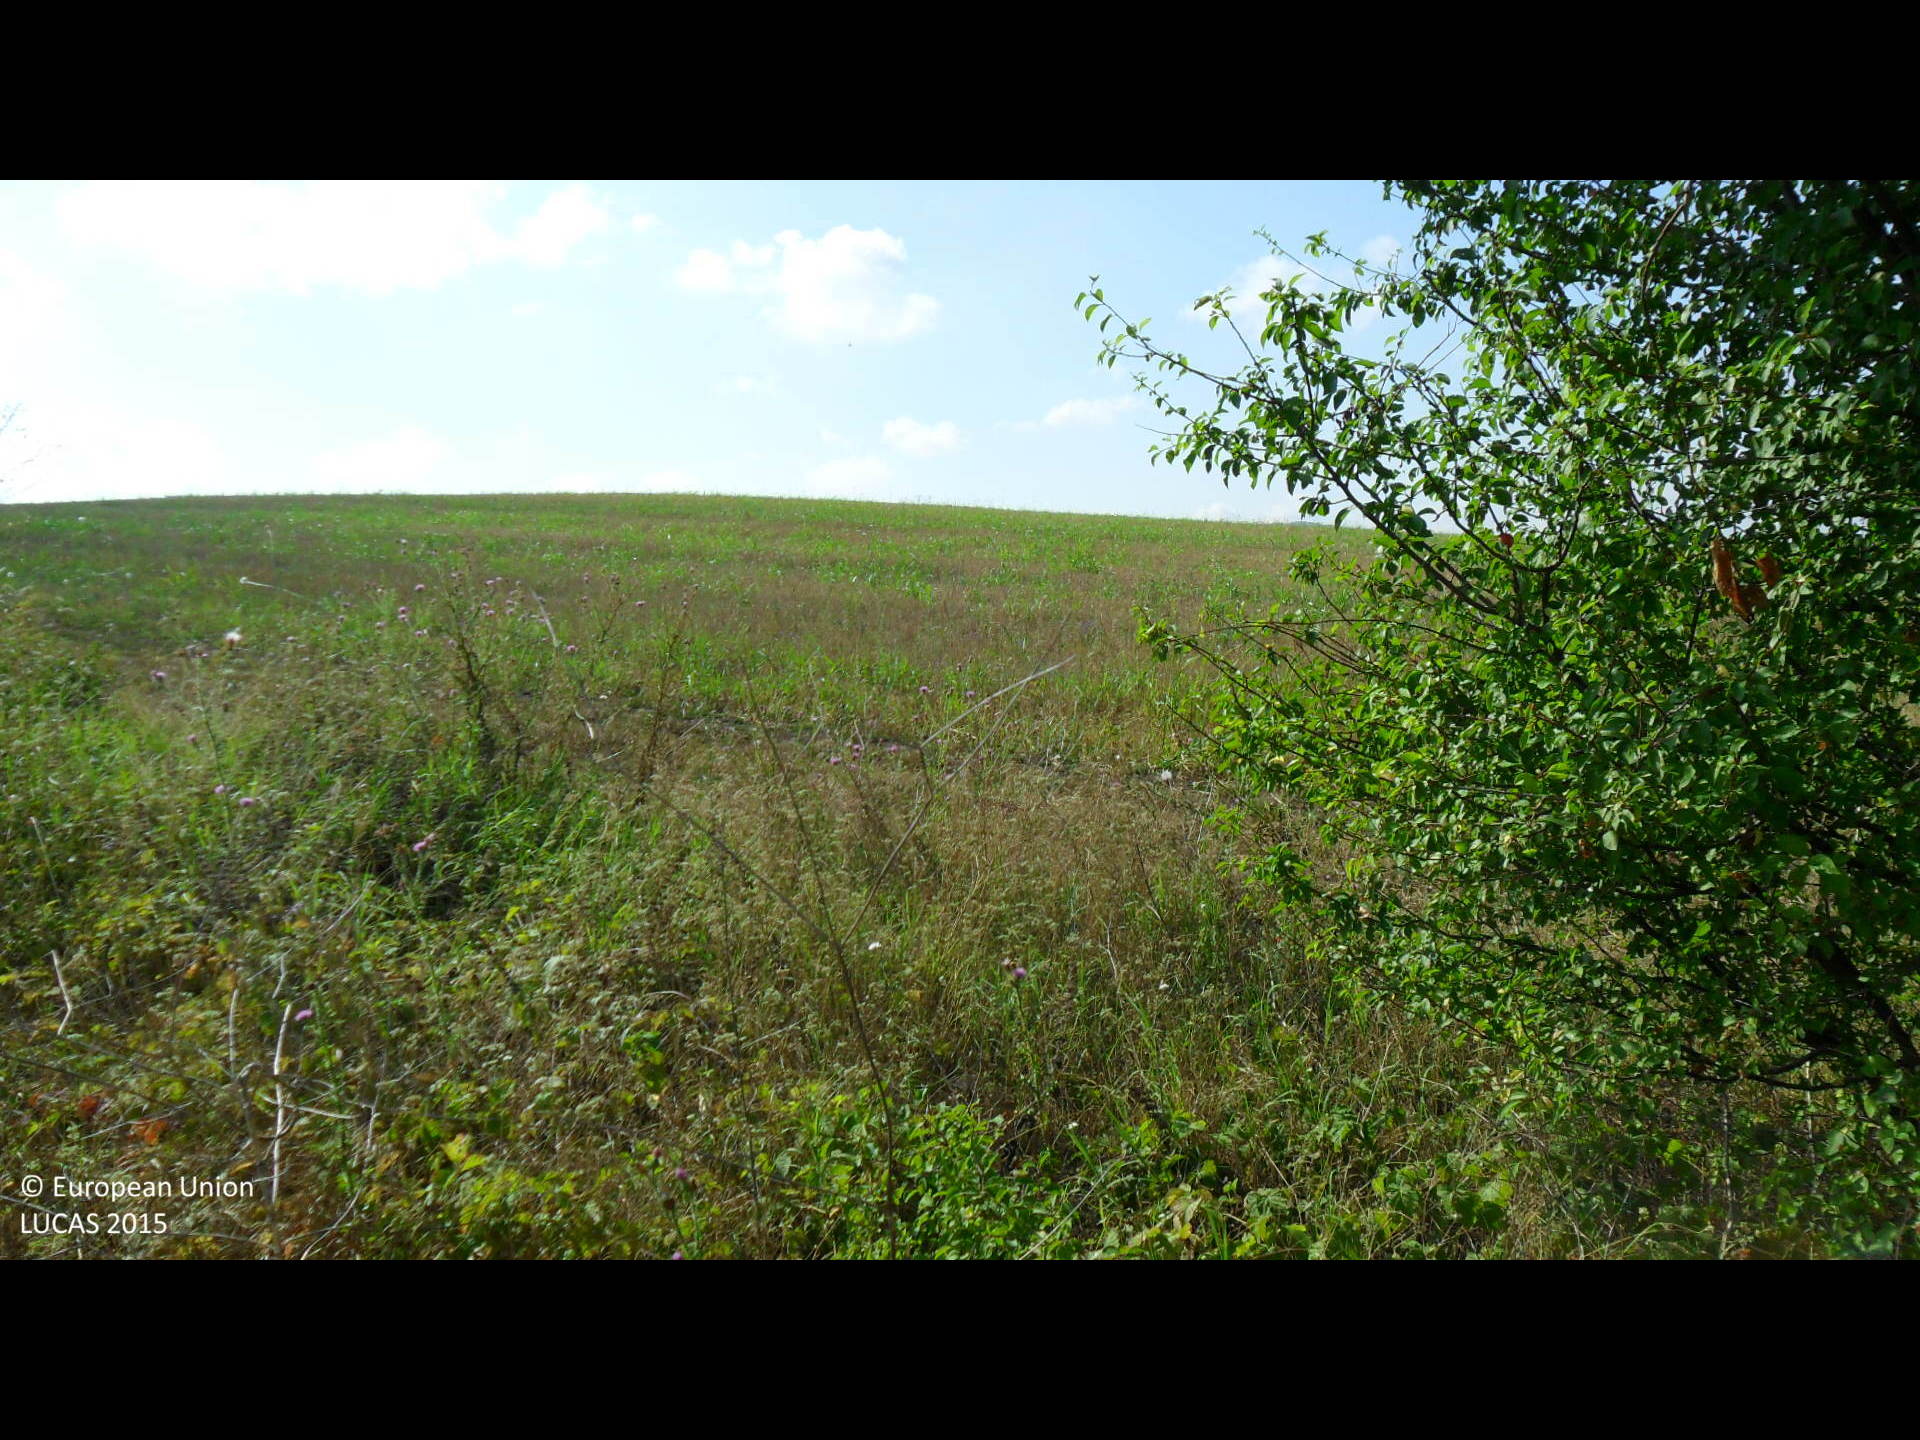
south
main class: Cropland
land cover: Sunflower
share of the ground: > 75 %
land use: Agriculture (excluding fallow land and kitchen gardens)
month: August
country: BG
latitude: 43.3987
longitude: 26.3102
